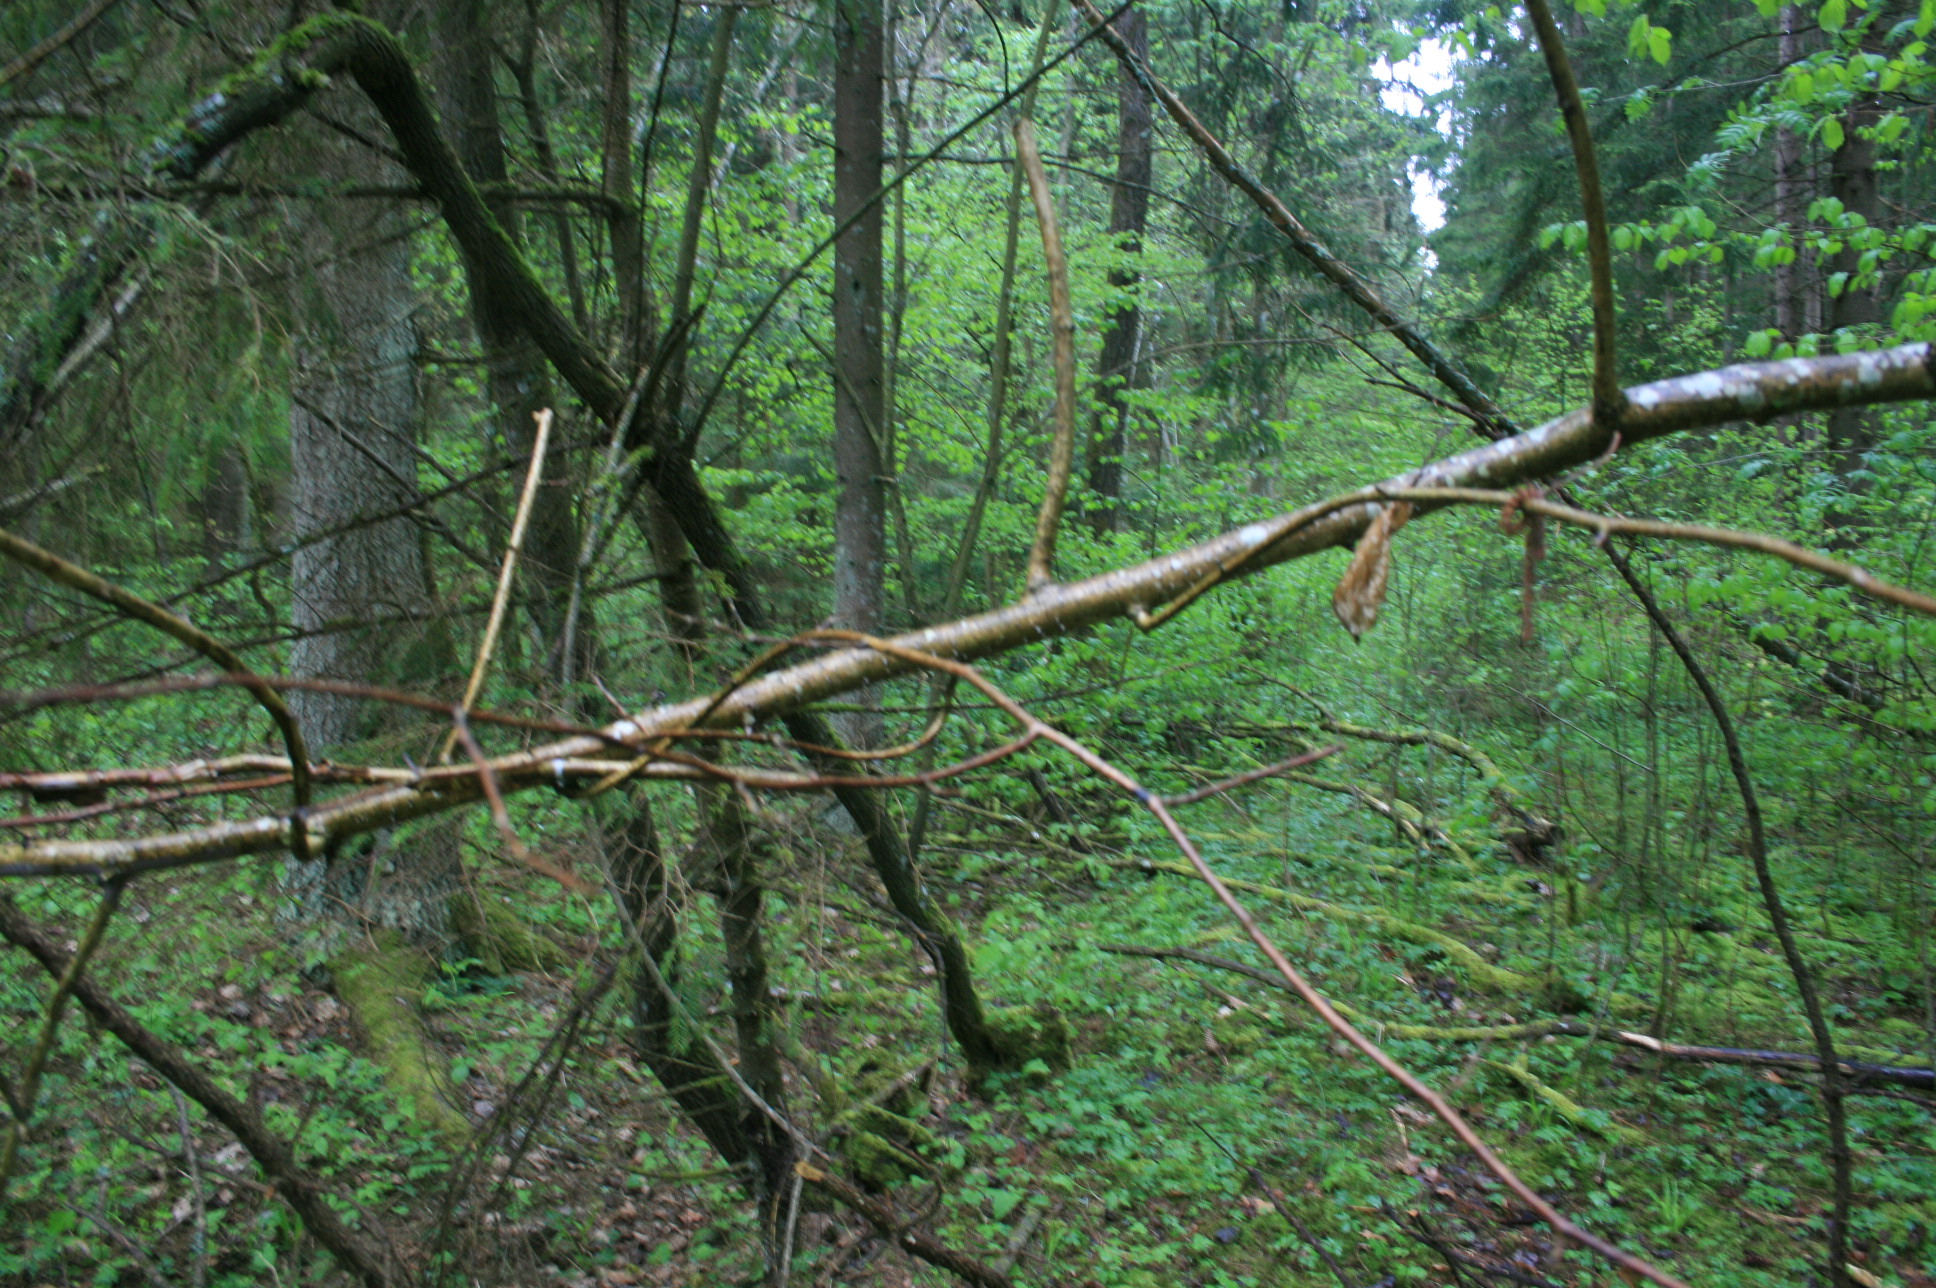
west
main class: Woodland
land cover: Spruce dominated mixed woodland
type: hemiboreal forest and nemoral coniferous forest and mixed broadleaved-coniferous forest
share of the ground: > 75 %
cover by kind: coniferous forest trees 70 %, broadleaved forest trees 25 %, lichens and mosses 5 %
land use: Forestry
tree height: > 5 m
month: May
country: LT
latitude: 56.2080
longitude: 21.9638
